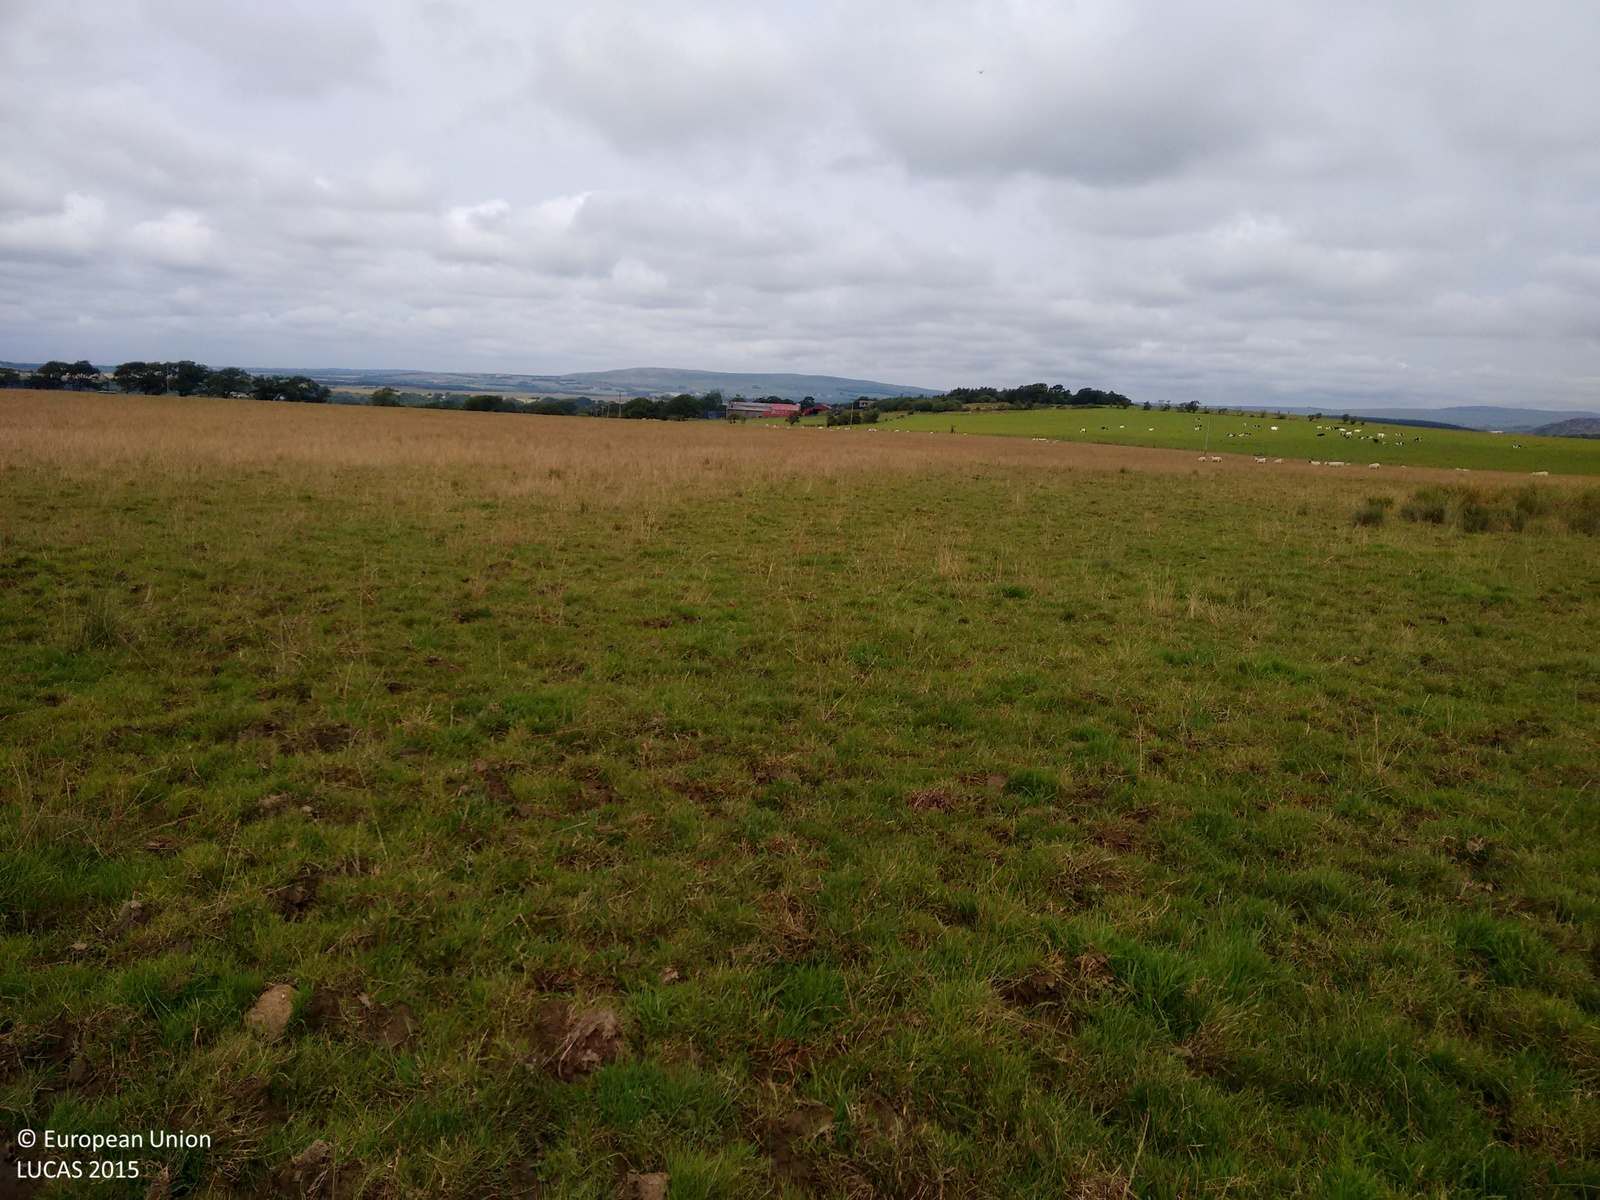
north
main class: Grassland
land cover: Grassland without tree/shrub cover
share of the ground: > 75 %
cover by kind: herbaceous plants 100 %
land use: Agriculture (excluding fallow land and kitchen gardens)
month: August
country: GB
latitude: 55.4460
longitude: -4.2113
